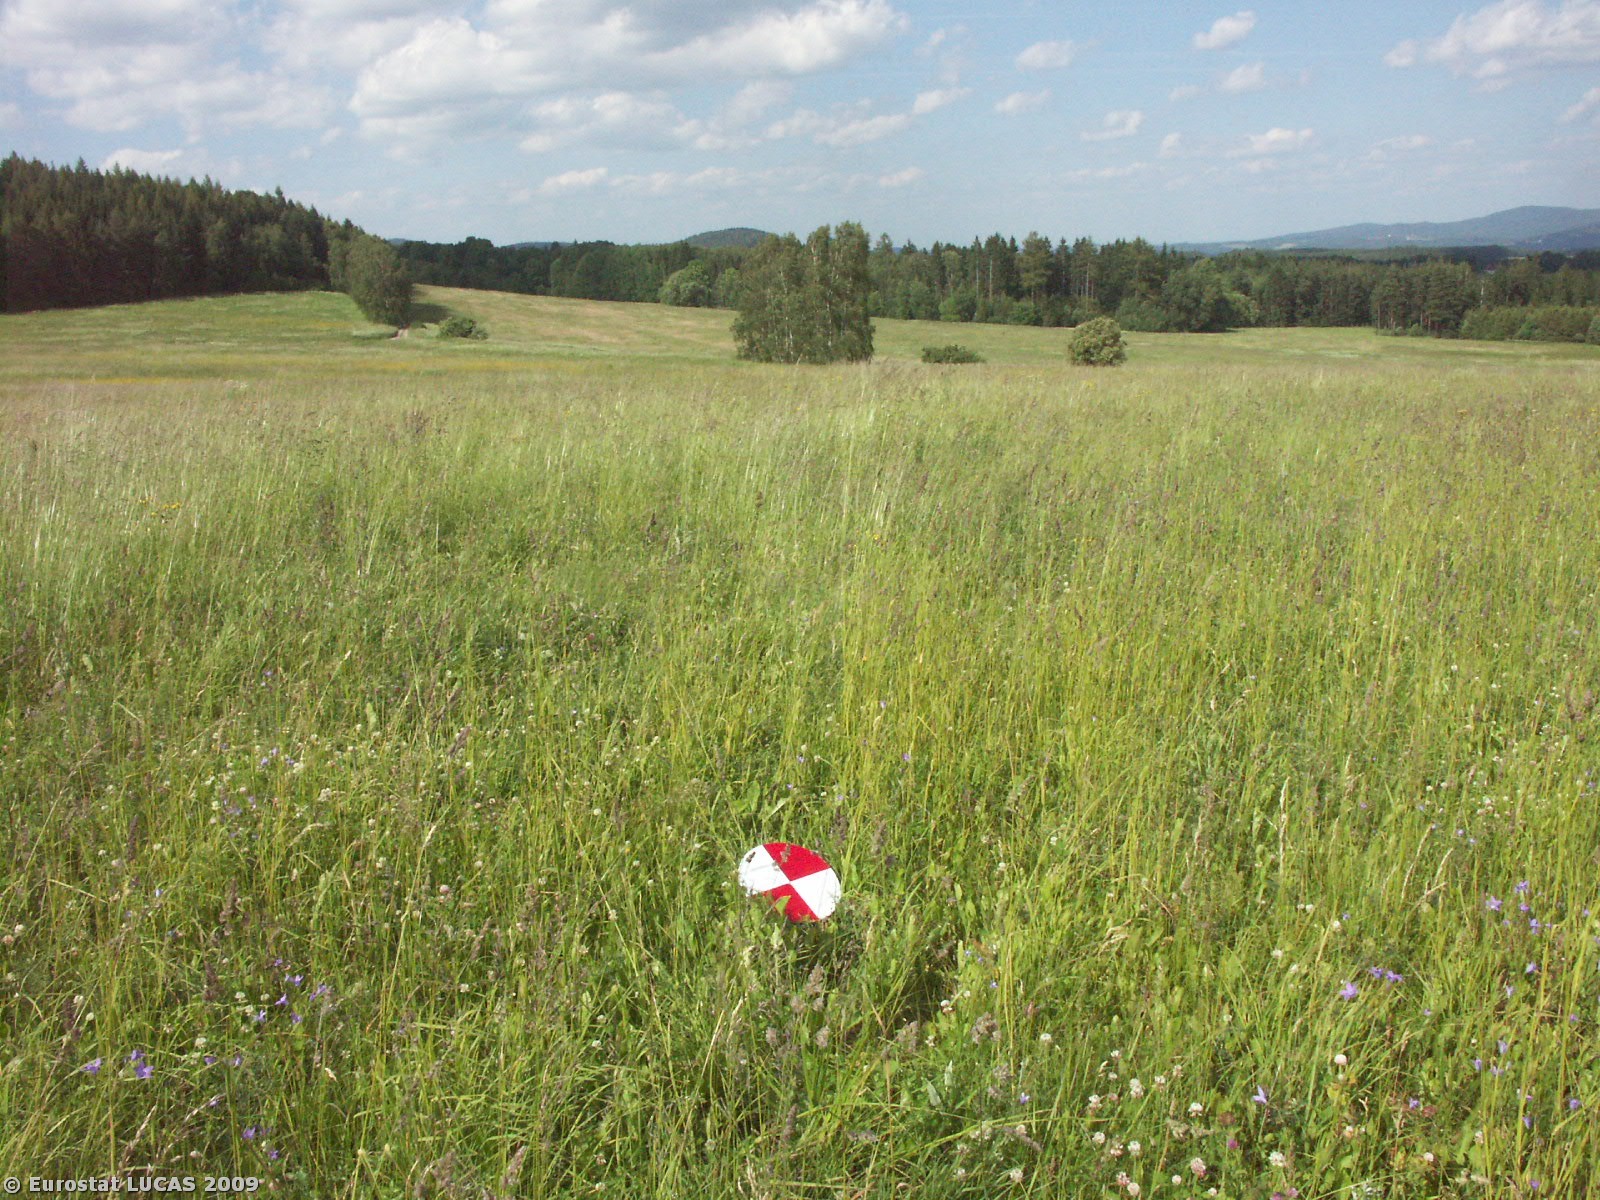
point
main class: Grassland
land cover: Grassland without tree/shrub cover
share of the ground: > 75 %
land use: Agriculture (excluding fallow land and kitchen gardens)
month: June
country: CZ
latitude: 48.6937
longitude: 14.4161
